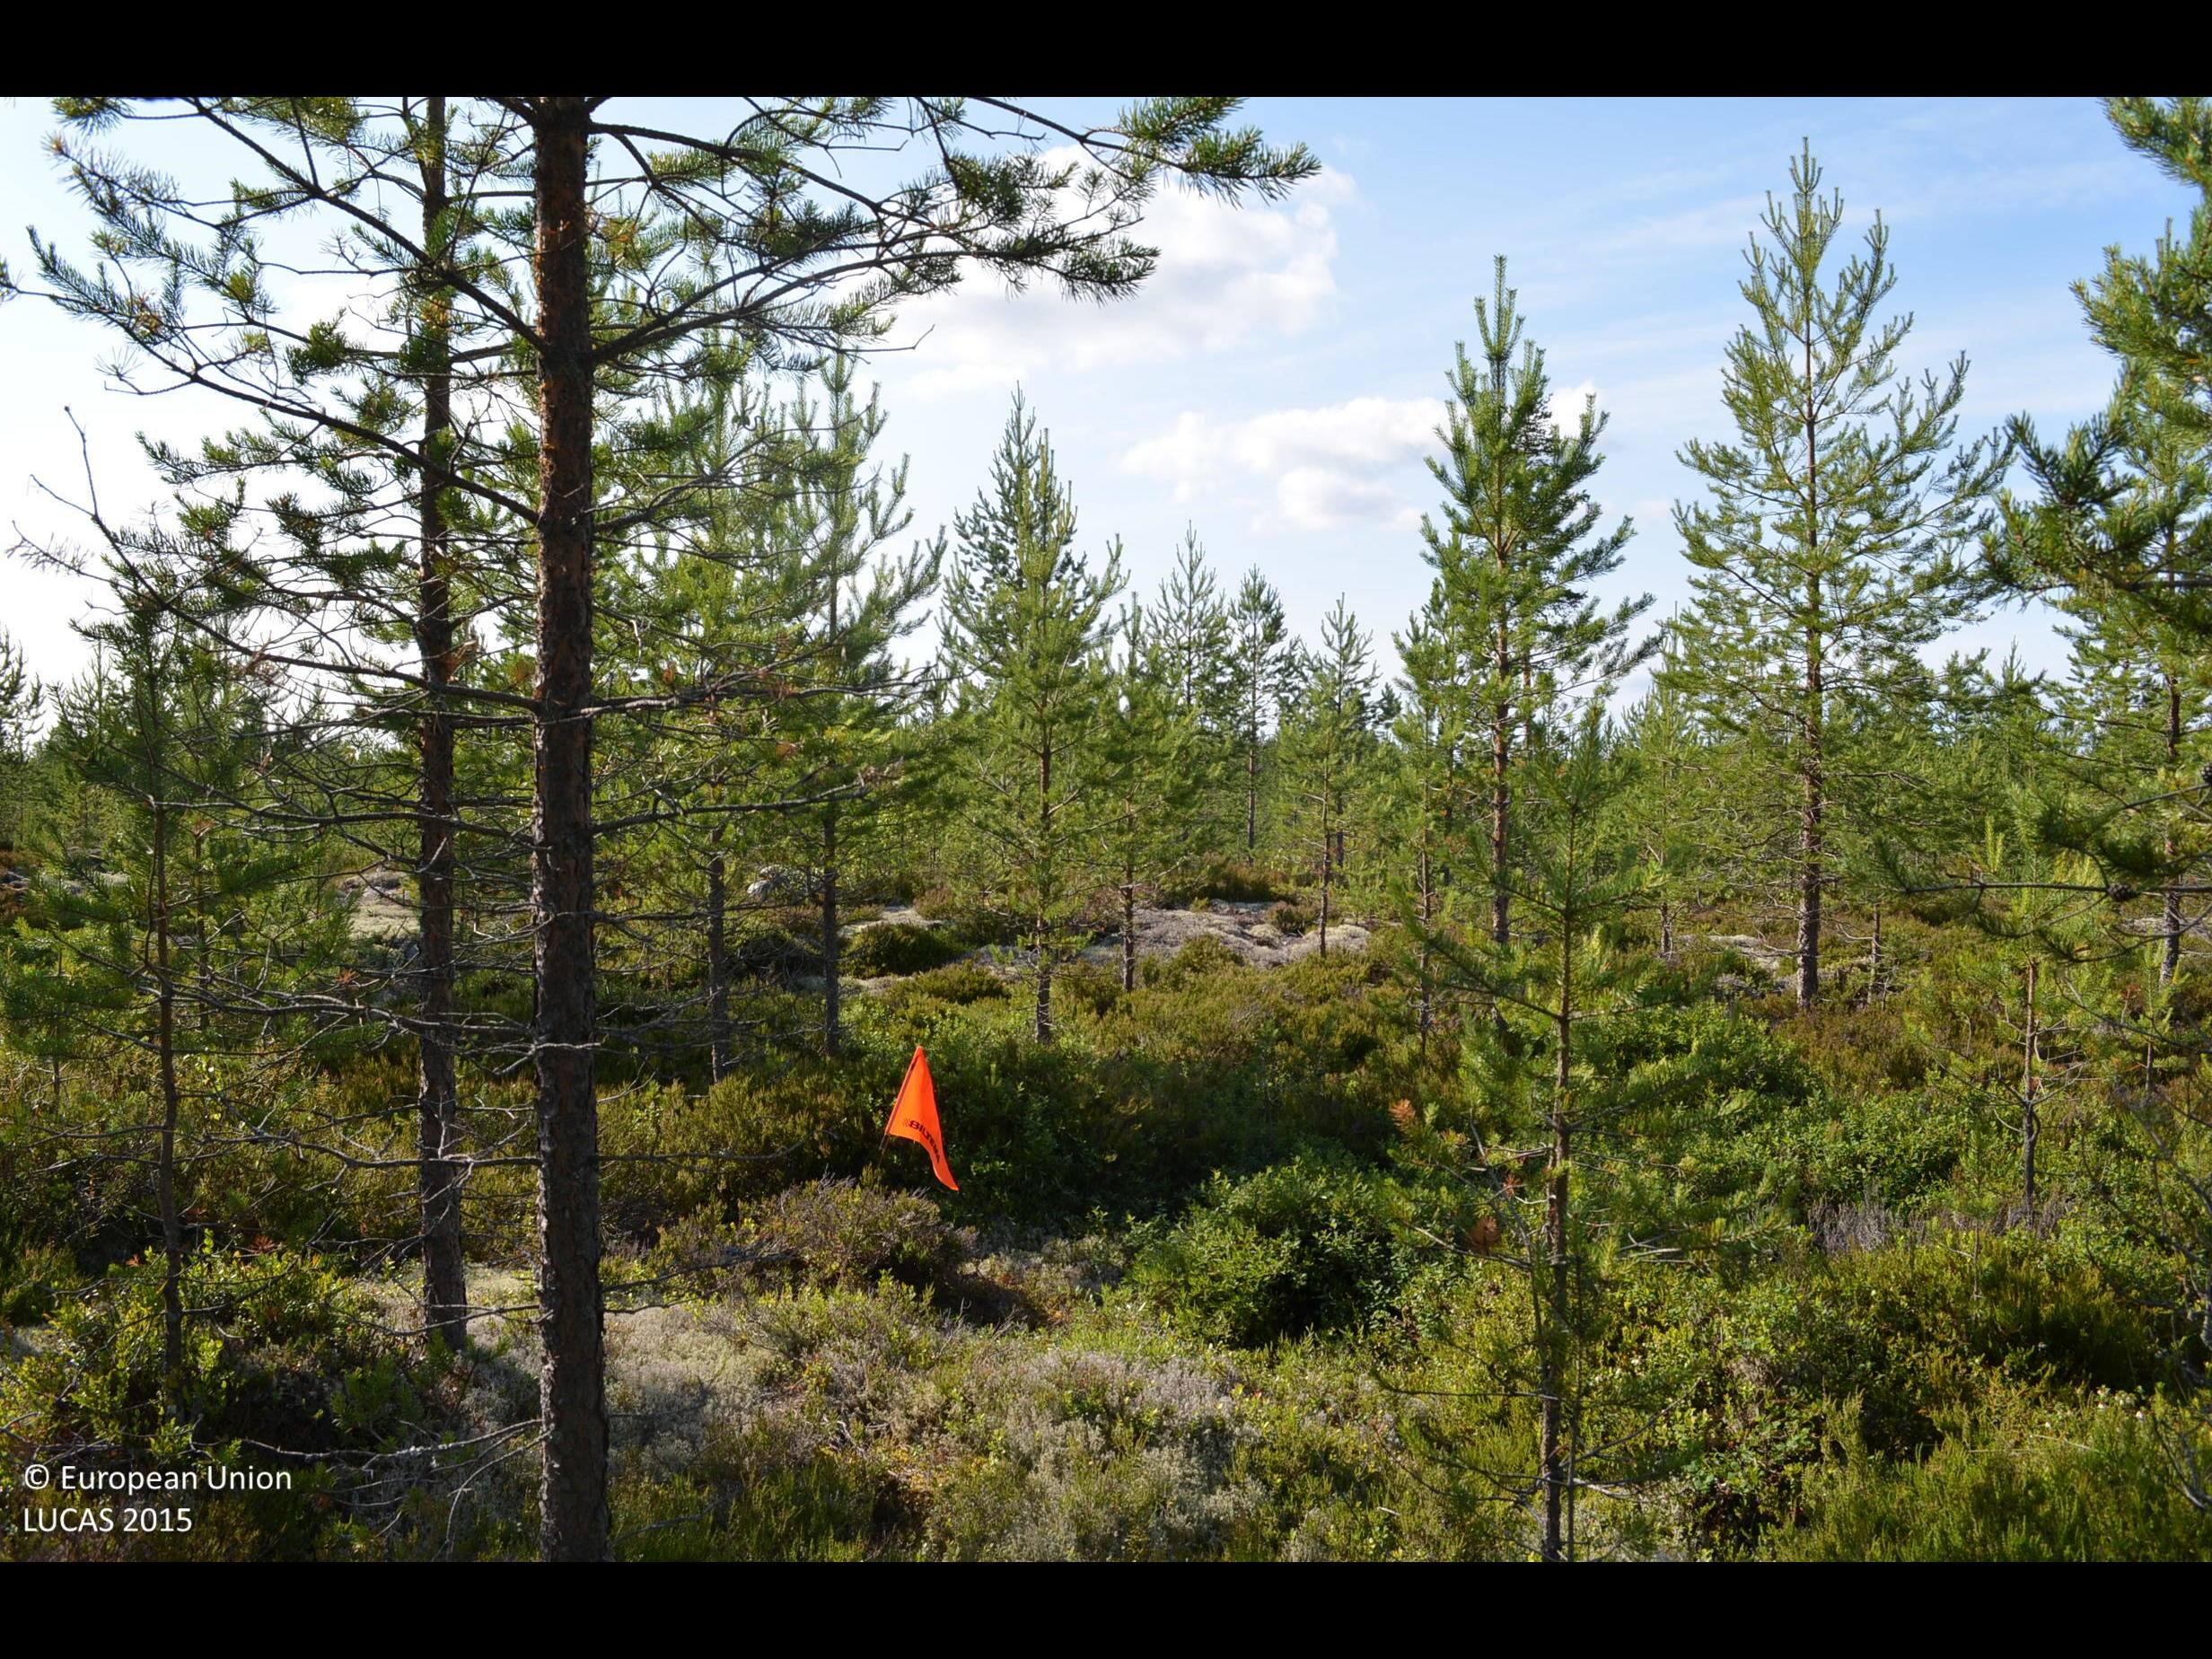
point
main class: Woodland
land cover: Pine dominated coniferous woodland
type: boreal forest
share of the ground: 50 - 75 %
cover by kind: coniferous forest trees 50 %, shrubs 35 %, lichens and mosses 15 %
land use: Forestry
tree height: < 5 m
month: July
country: FI
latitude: 62.3392
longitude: 23.6098
